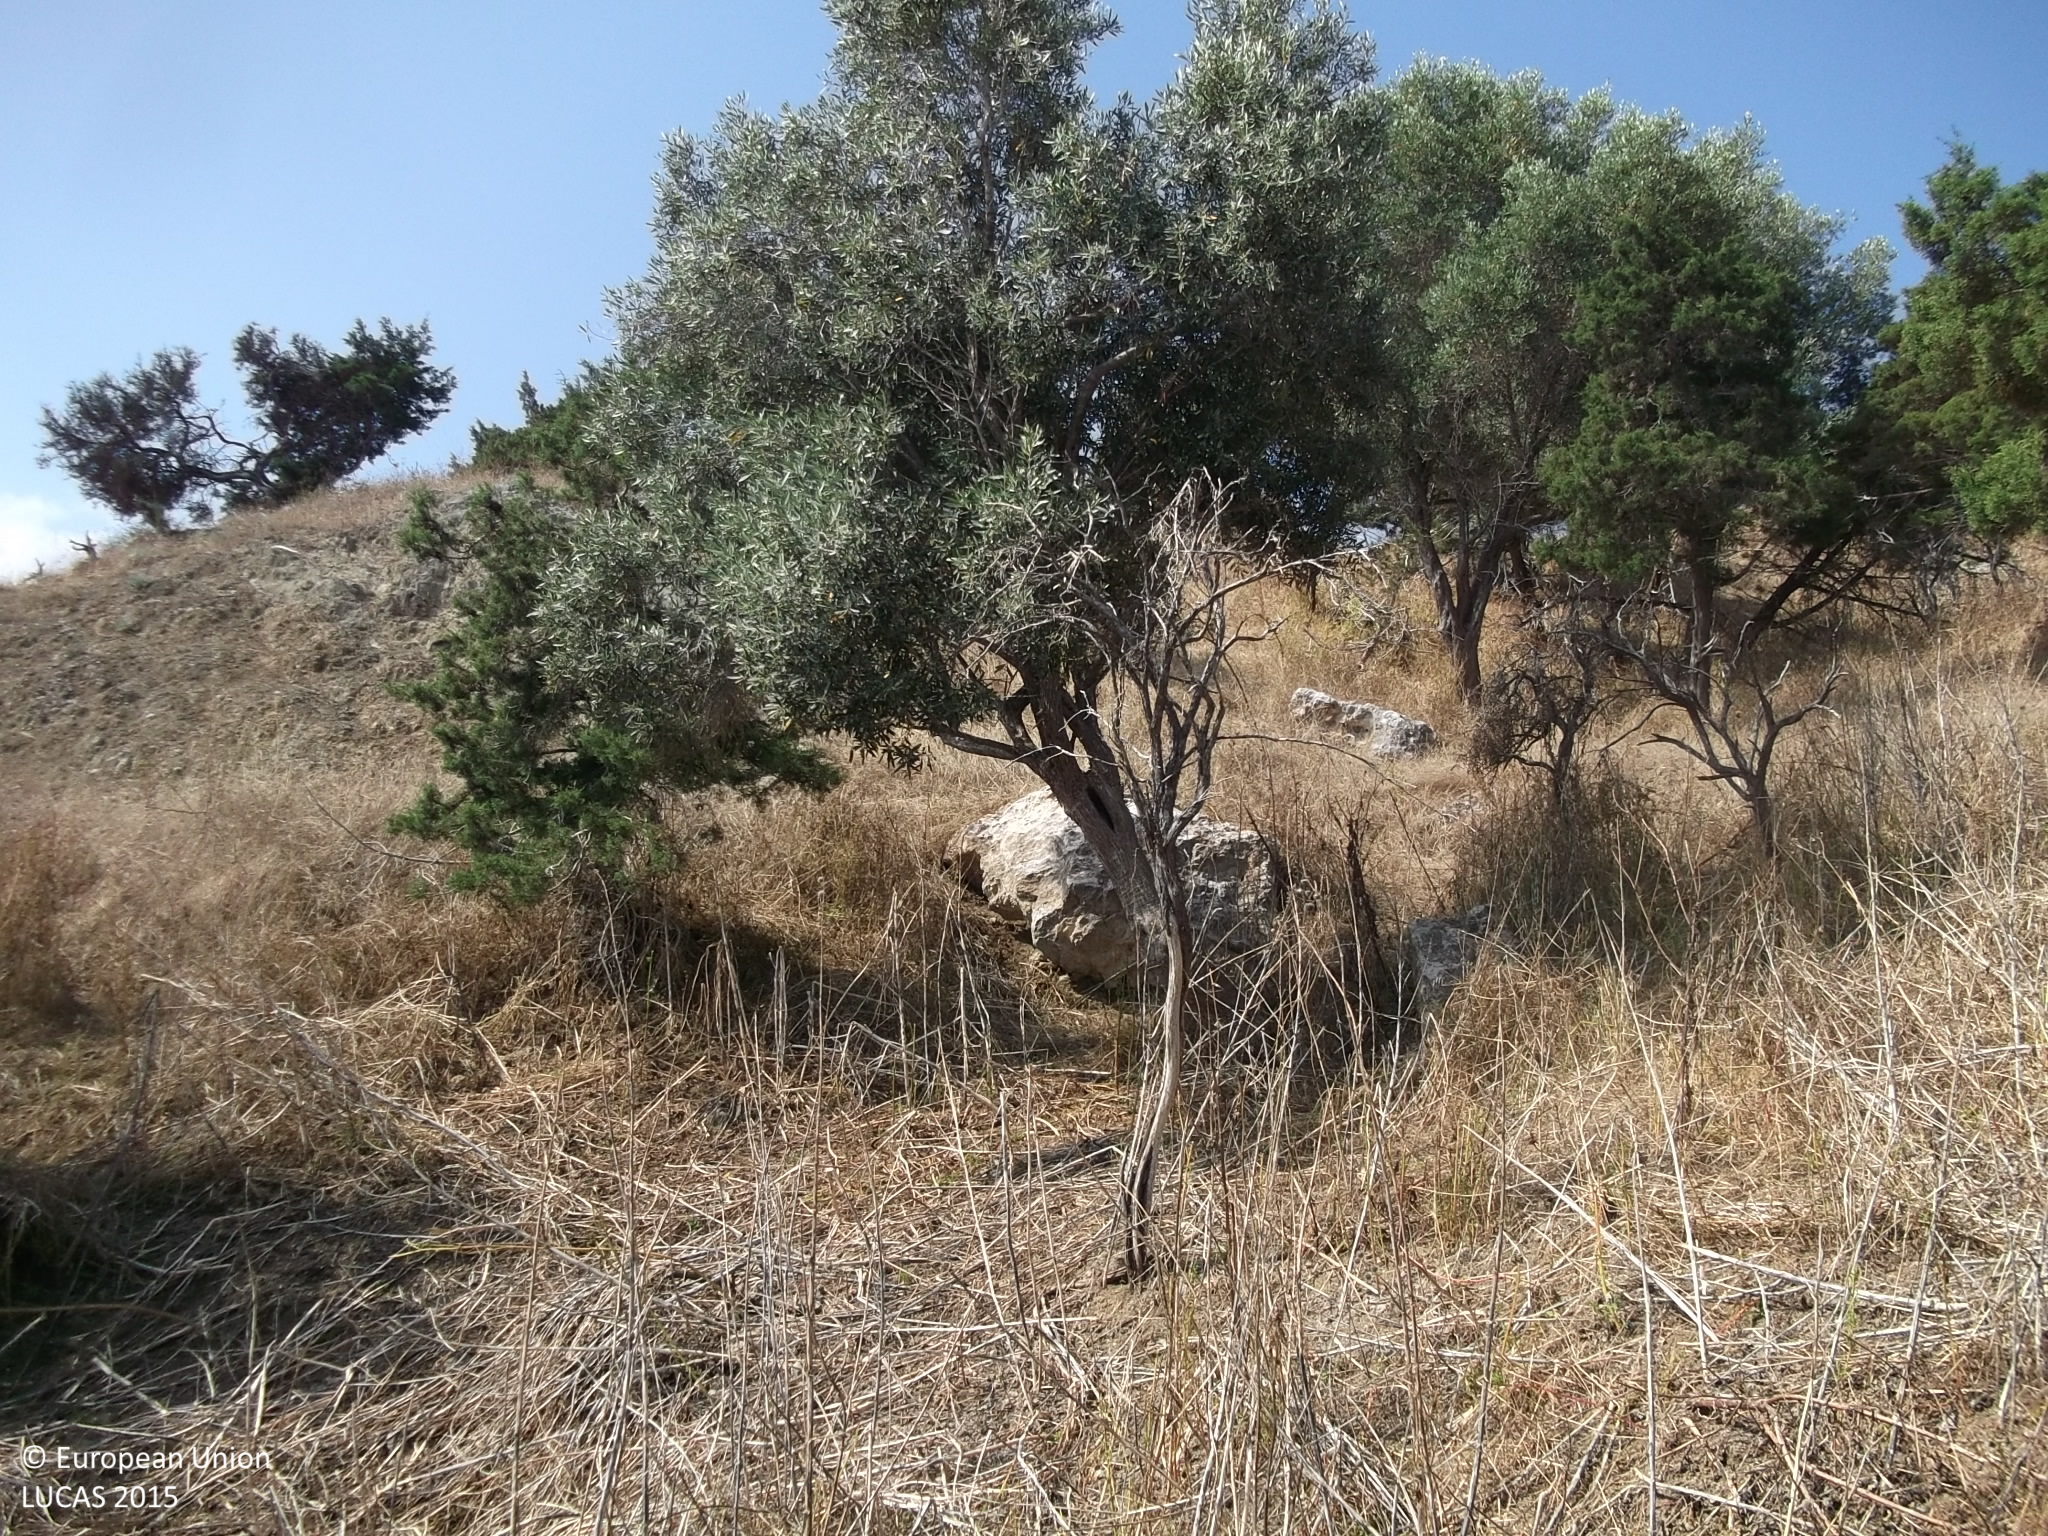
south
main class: Woodland
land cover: Other mixed woodland
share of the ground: 50 - 75 %
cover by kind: herbaceous plants 50 %, coniferous forest trees 30 %, broadleaved forest trees 20 %
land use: Agriculture (excluding fallow land and kitchen gardens)
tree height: < 5 m
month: May
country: CY
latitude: 35.0837
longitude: 32.2944
